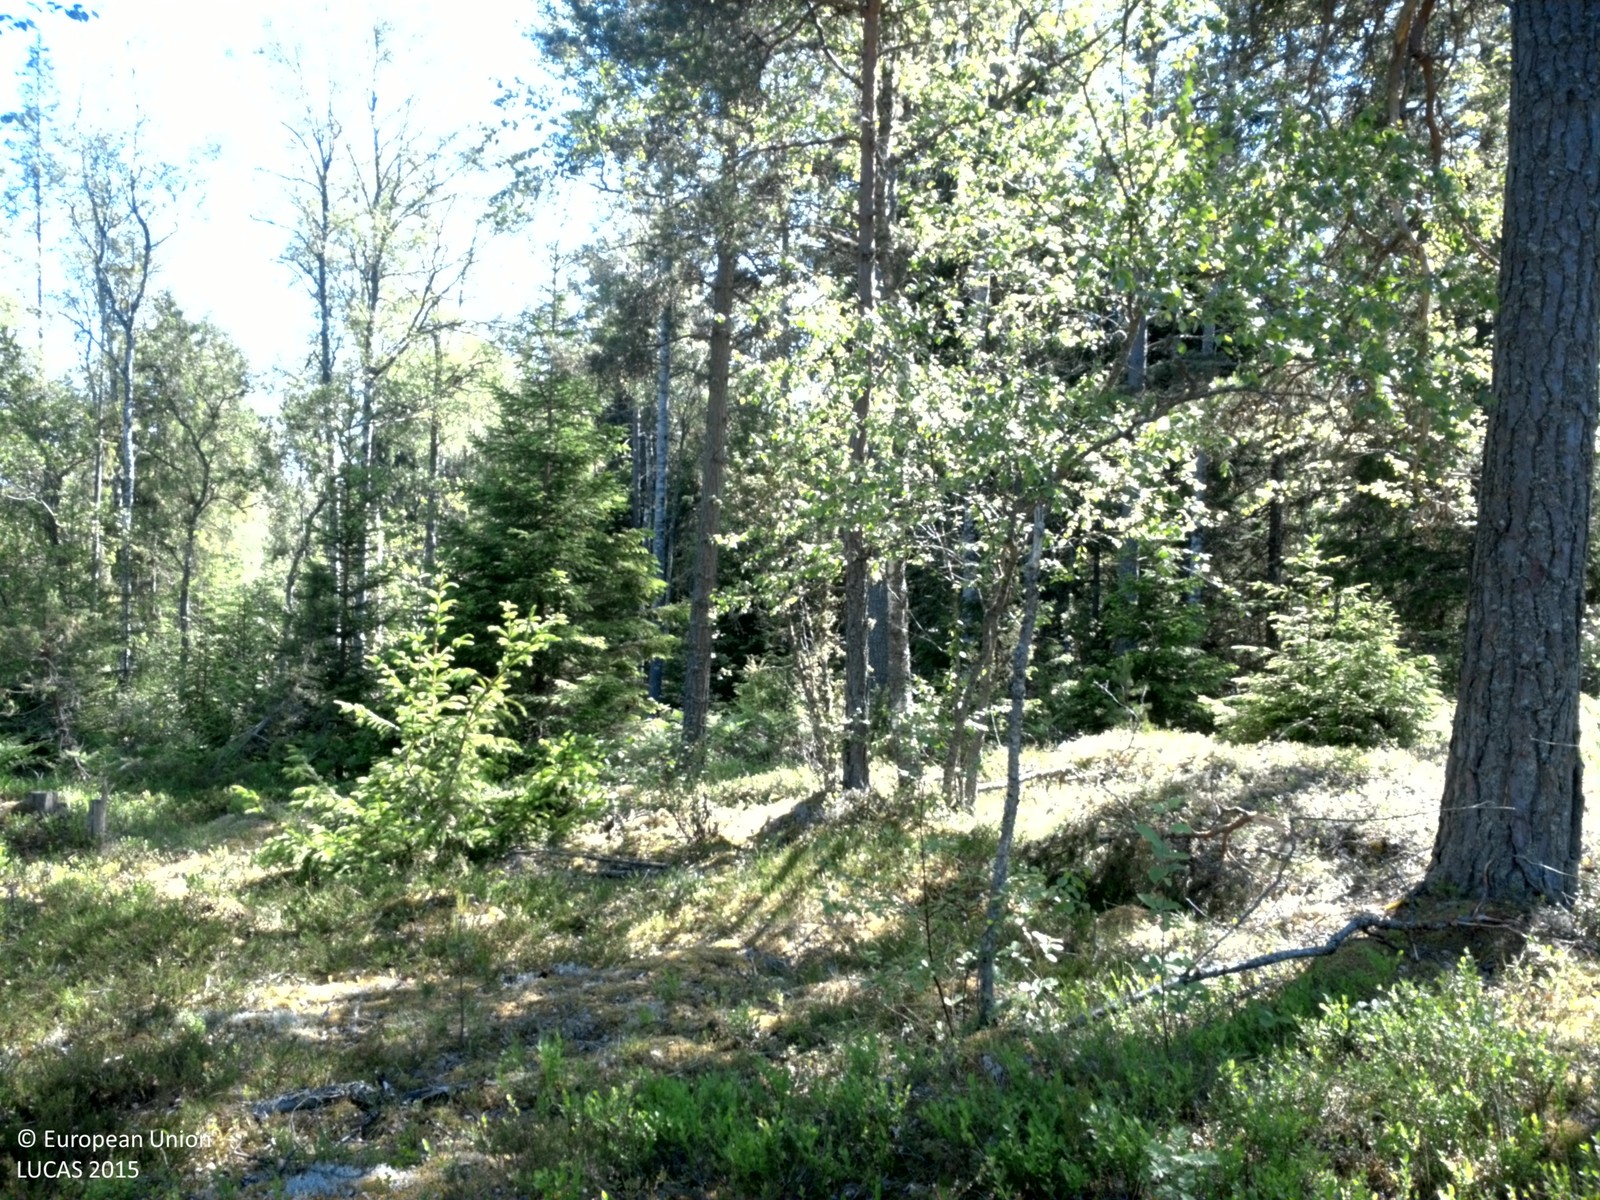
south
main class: Woodland
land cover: Pine dominated coniferous woodland
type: boreal forest
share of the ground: 25 - 50 %
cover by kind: herbaceous plants 35 %, coniferous forest trees 30 %, lichens and mosses 30 %, broadleaved forest trees 5 %
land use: Forestry
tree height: > 5 m
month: June
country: SE
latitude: 60.0404
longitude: 18.6692
